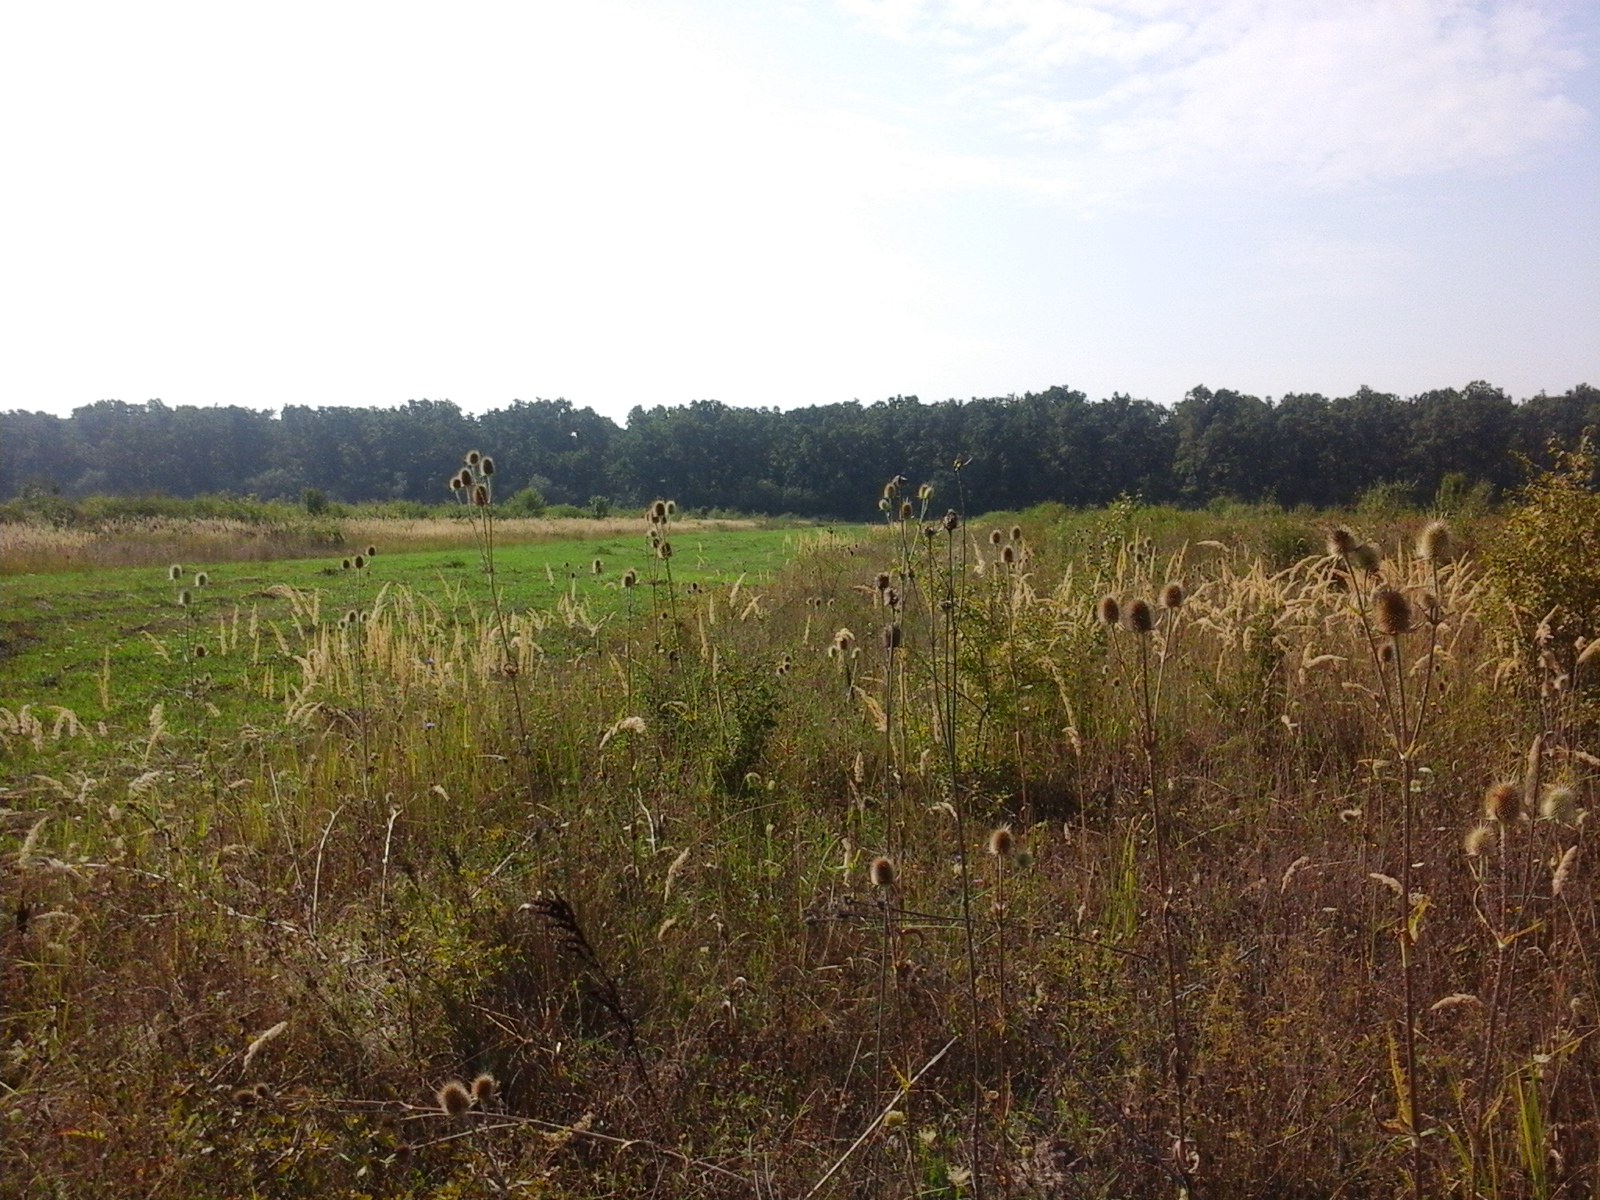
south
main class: Grassland
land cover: Spontaneously vegetated surfaces
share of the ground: > 75 %
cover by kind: herbaceous plants 100 %
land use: Agriculture (excluding fallow land and kitchen gardens)
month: August
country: RO
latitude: 46.6046
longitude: 21.8051
